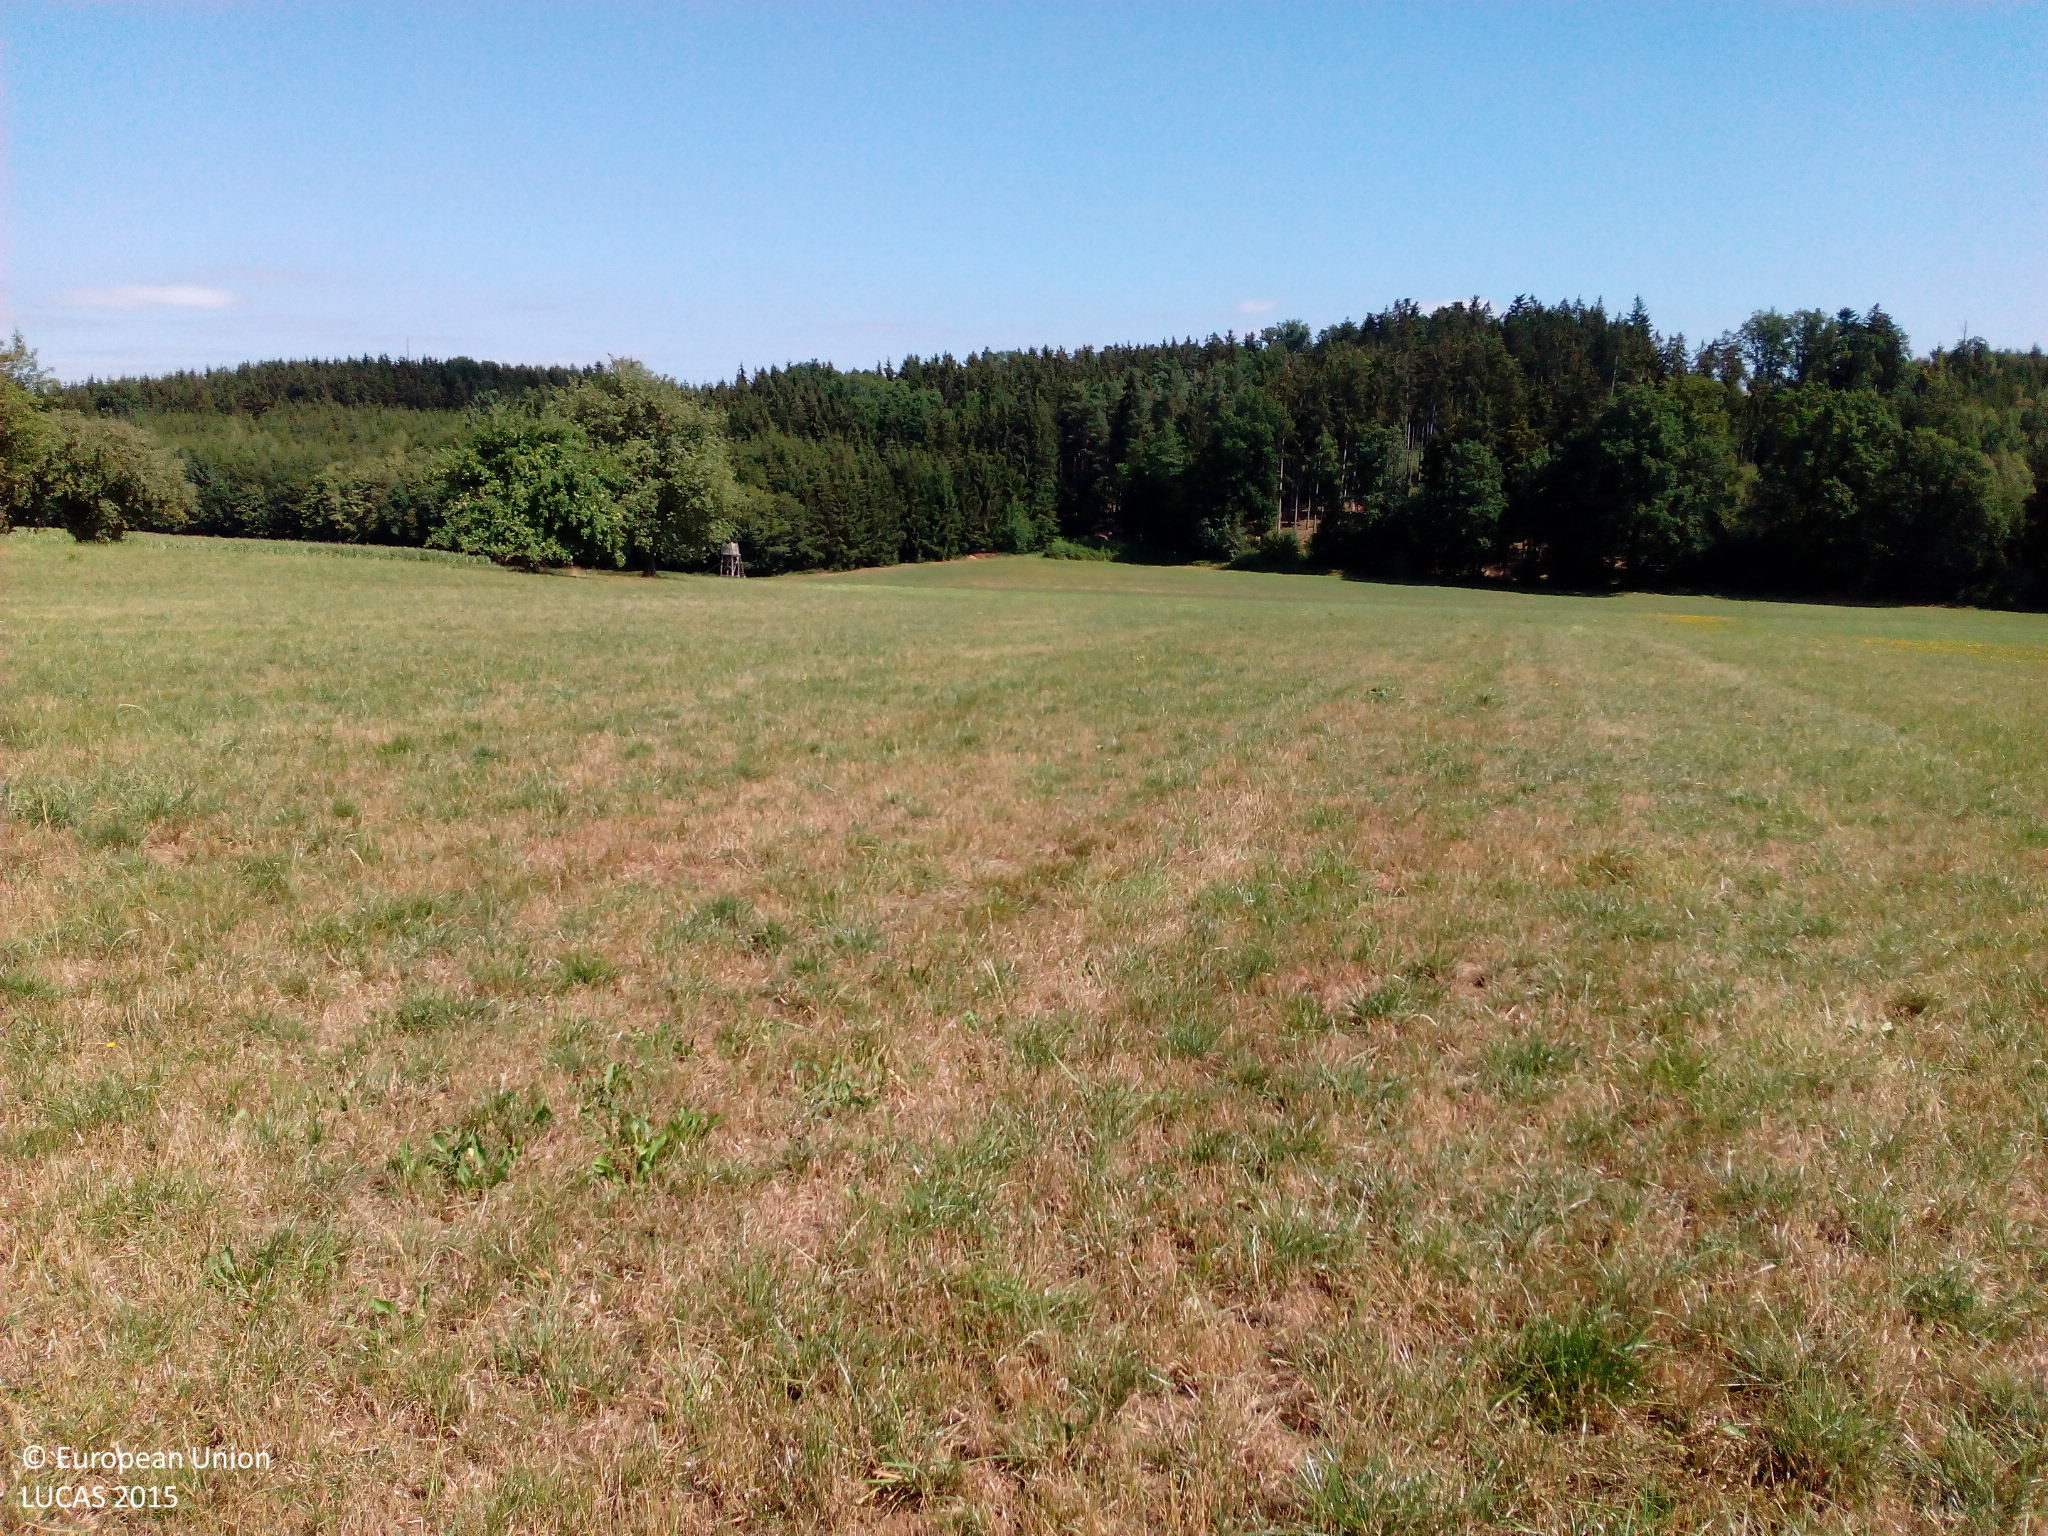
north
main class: Grassland
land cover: Grassland without tree/shrub cover
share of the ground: > 75 %
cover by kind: herbaceous plants 90 %, unconsolidated bare surface 10 %
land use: Agriculture (excluding fallow land and kitchen gardens)
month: August
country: DE
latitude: 48.9789
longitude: 10.2595
